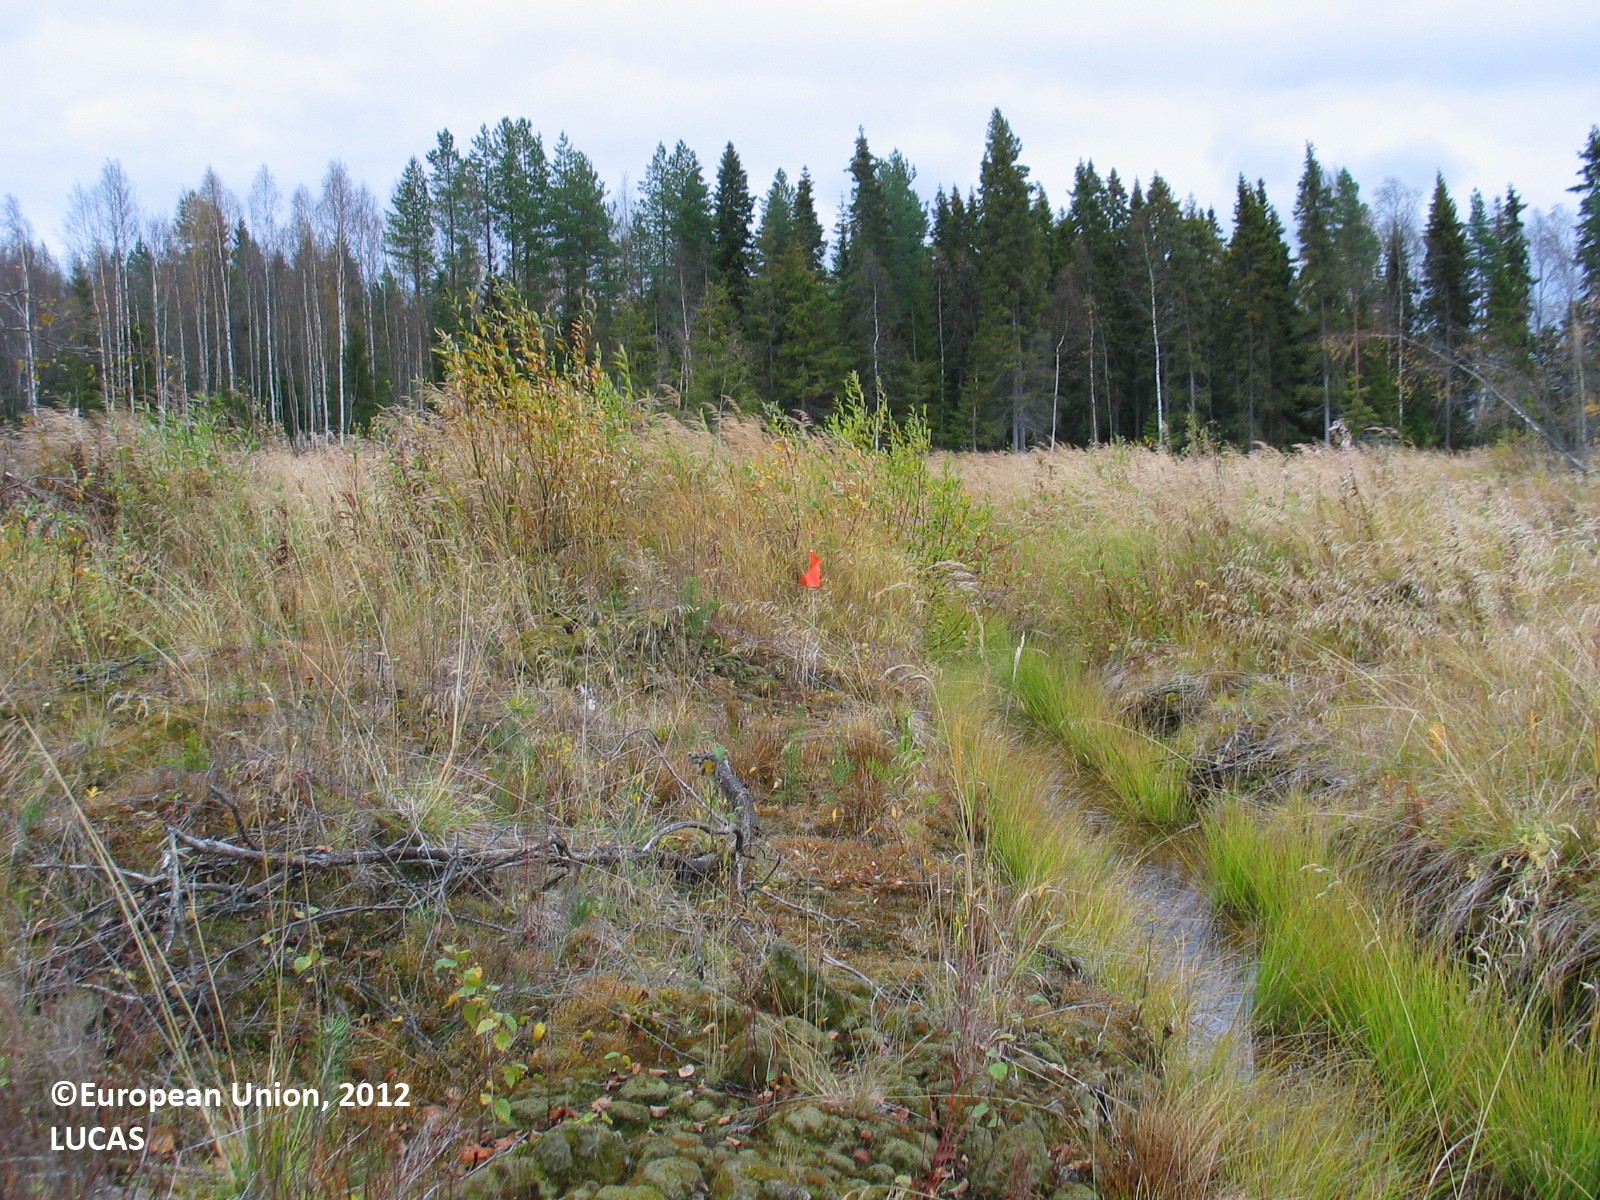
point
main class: Grassland
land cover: Grassland with sparse tree/shrub cover
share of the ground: > 75 %
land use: Forestry
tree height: < 5 m
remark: Clear cut
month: September
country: FI
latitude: 65.3218
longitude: 25.6013
